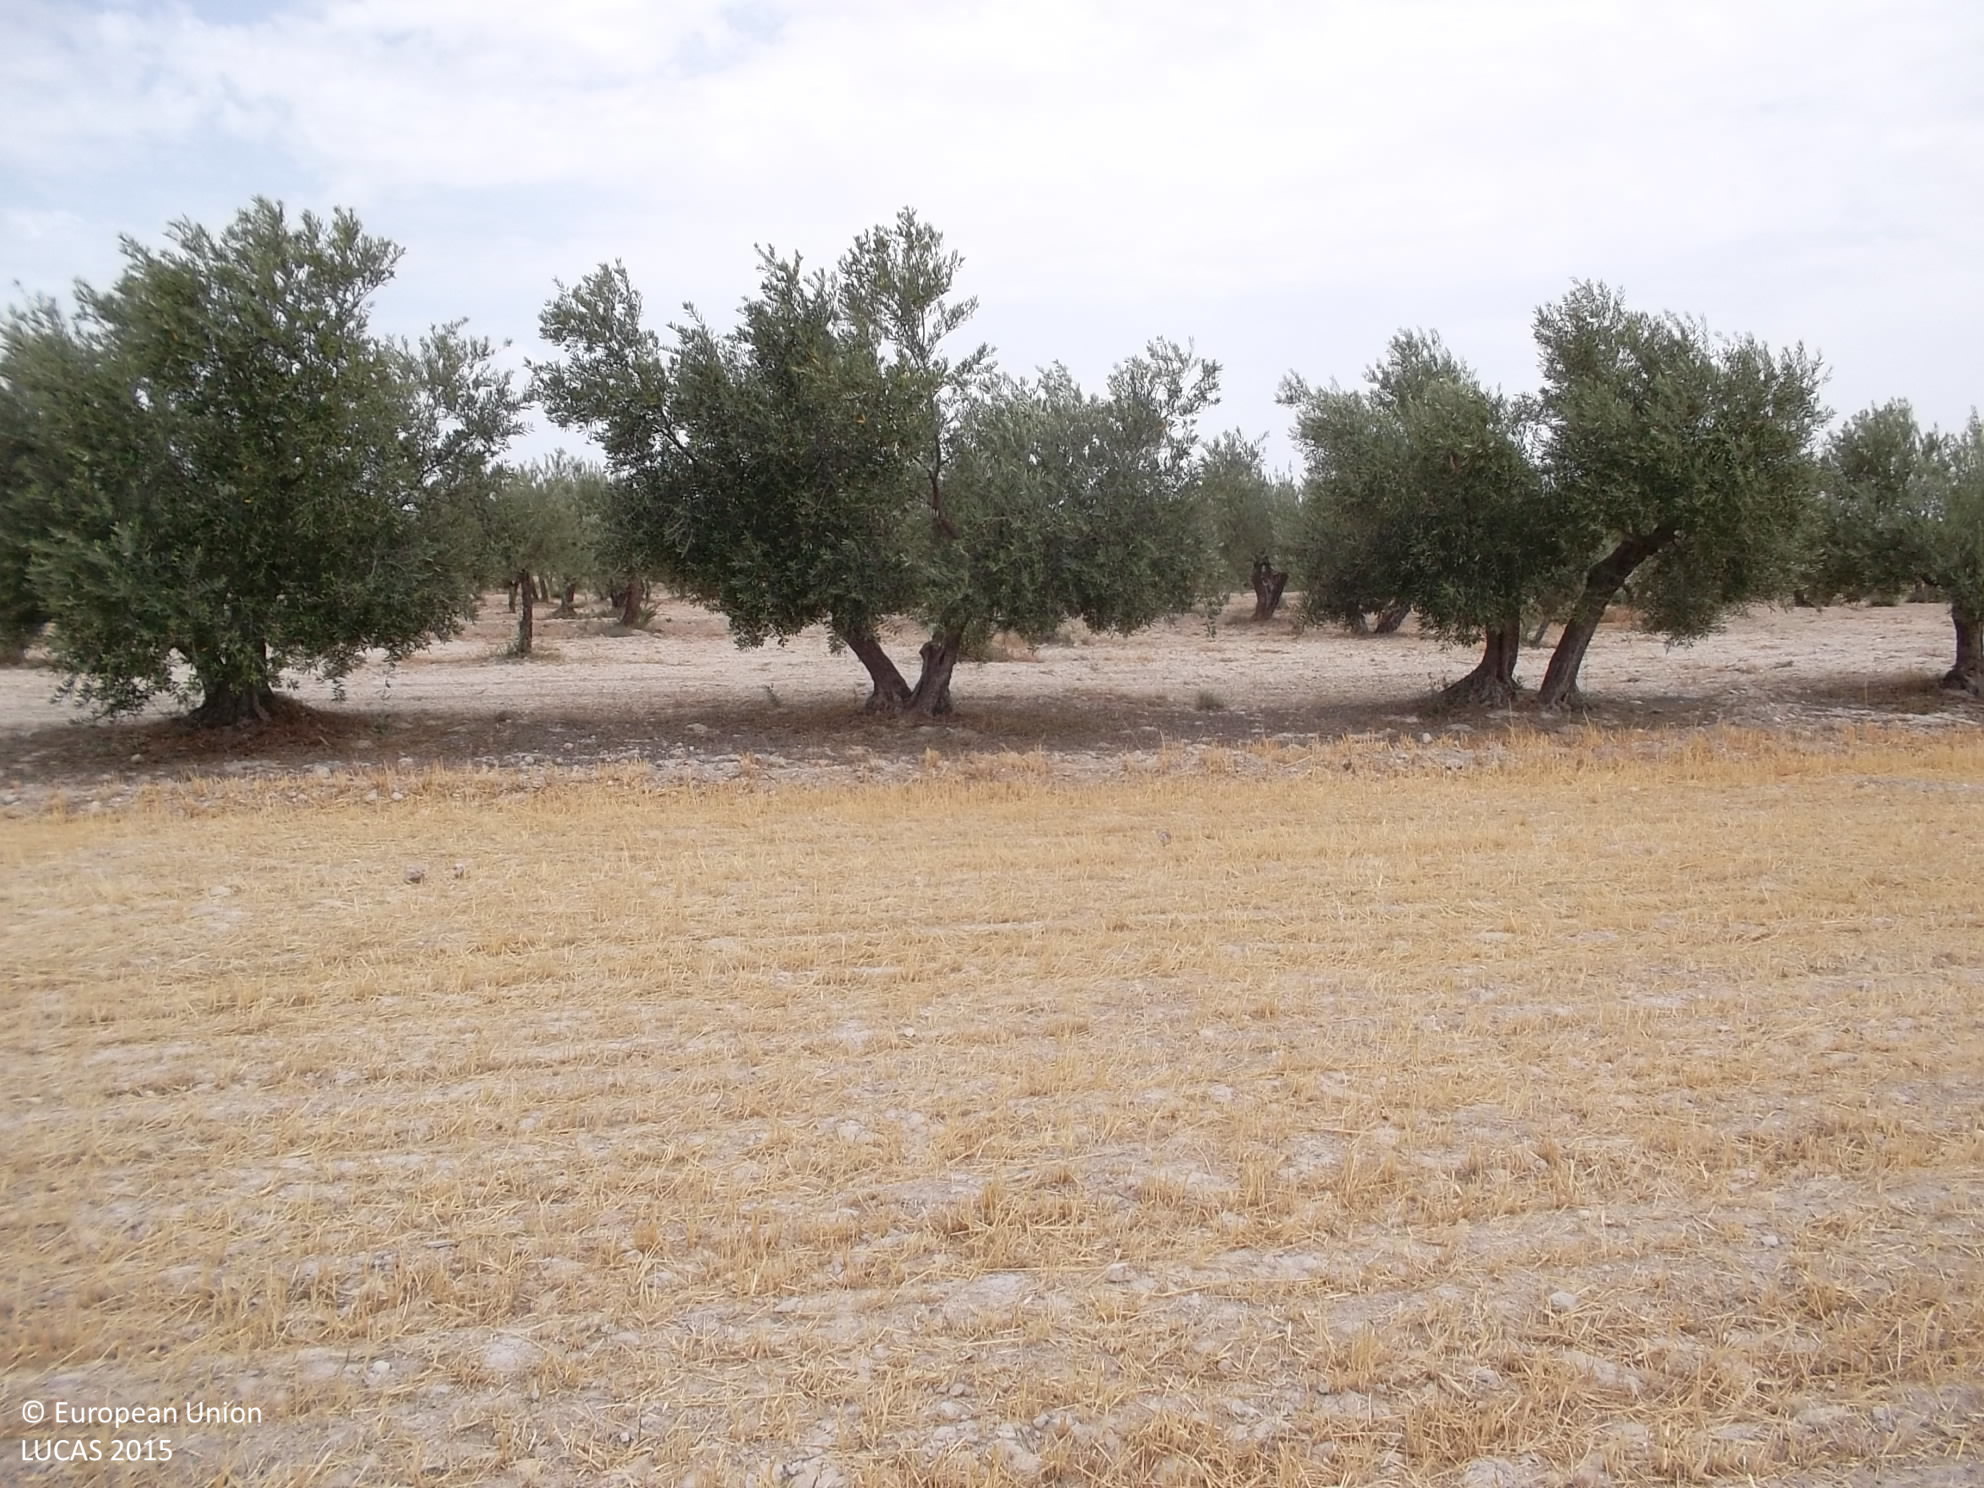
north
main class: Cropland
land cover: Common wheat
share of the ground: < 10 %
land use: Agriculture (excluding fallow land and kitchen gardens)
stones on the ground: < 10 %
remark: Harvested field
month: July
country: ES
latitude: 37.5286
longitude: -2.7403
